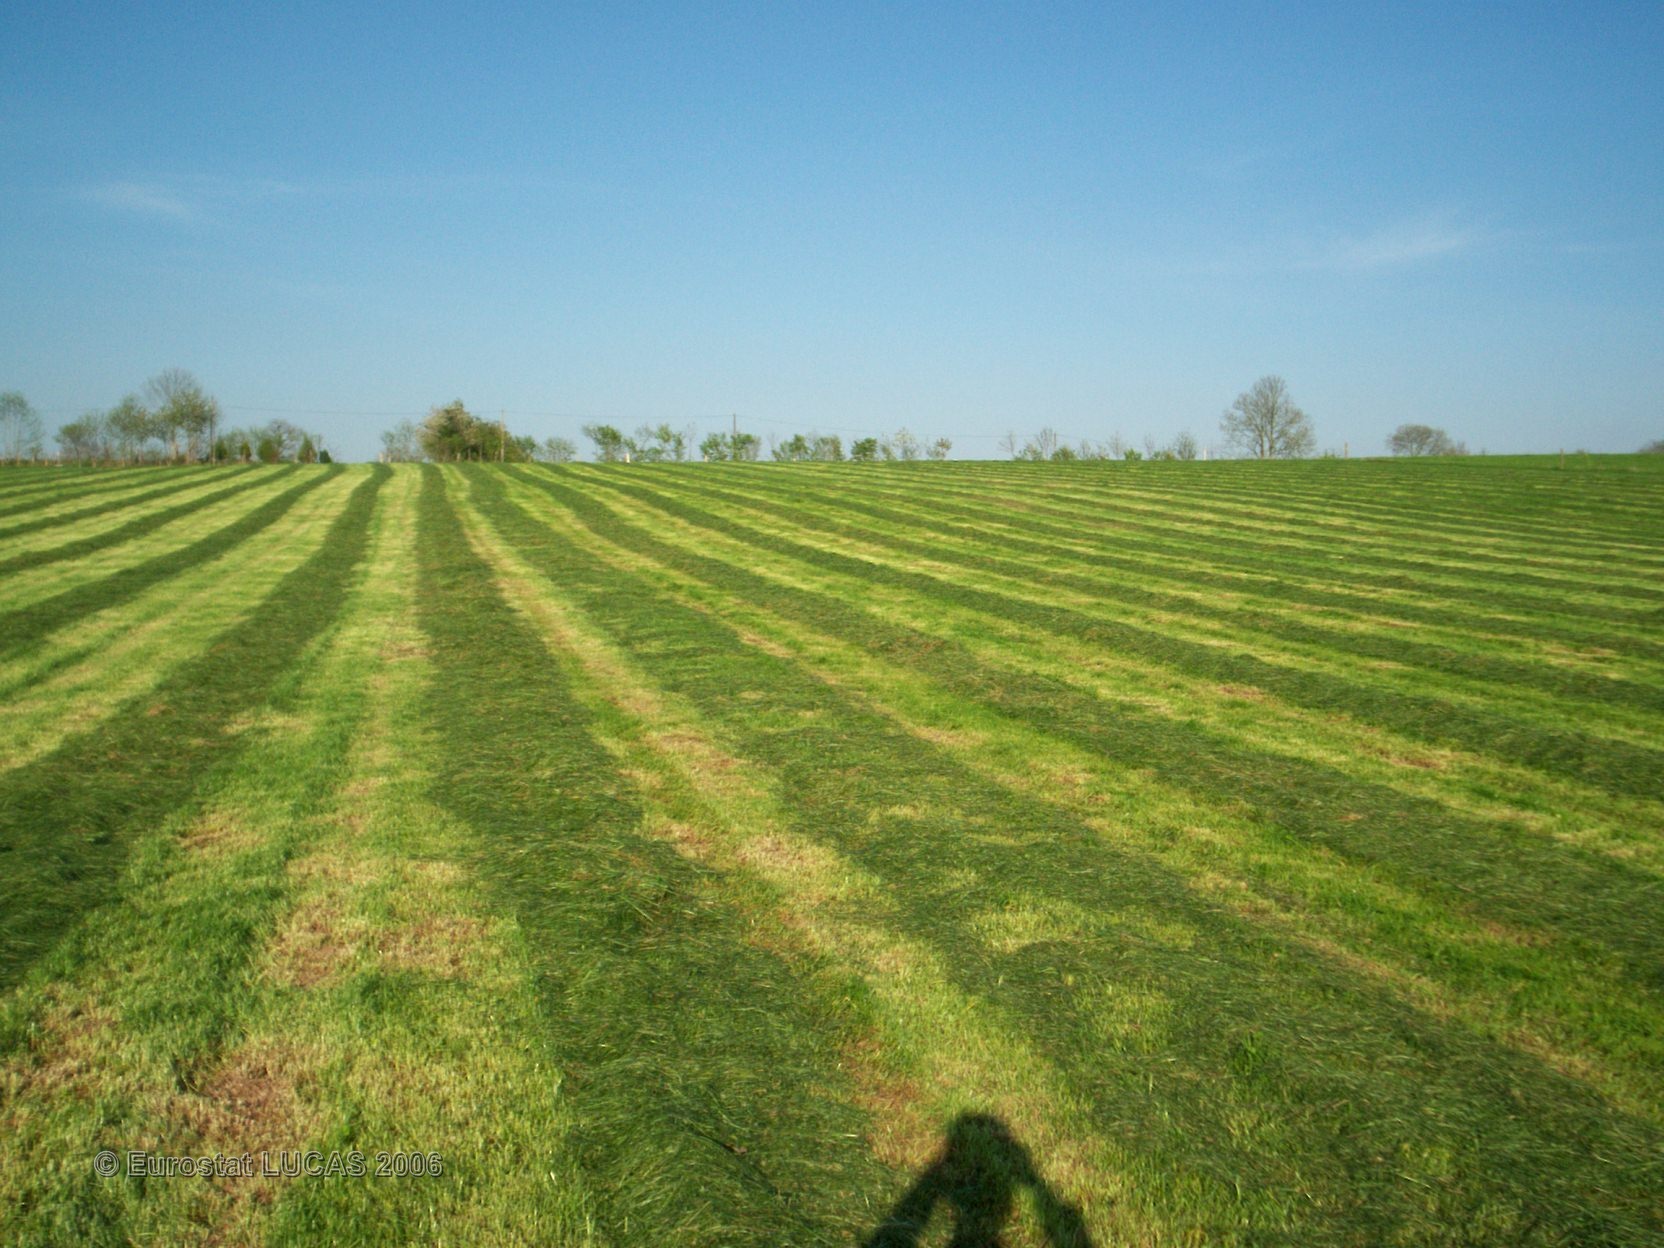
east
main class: Grassland
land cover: Grassland without tree/shrub cover
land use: Agriculture (excluding fallow land and kitchen gardens)
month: May
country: FR
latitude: 48.2523
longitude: -1.1803
